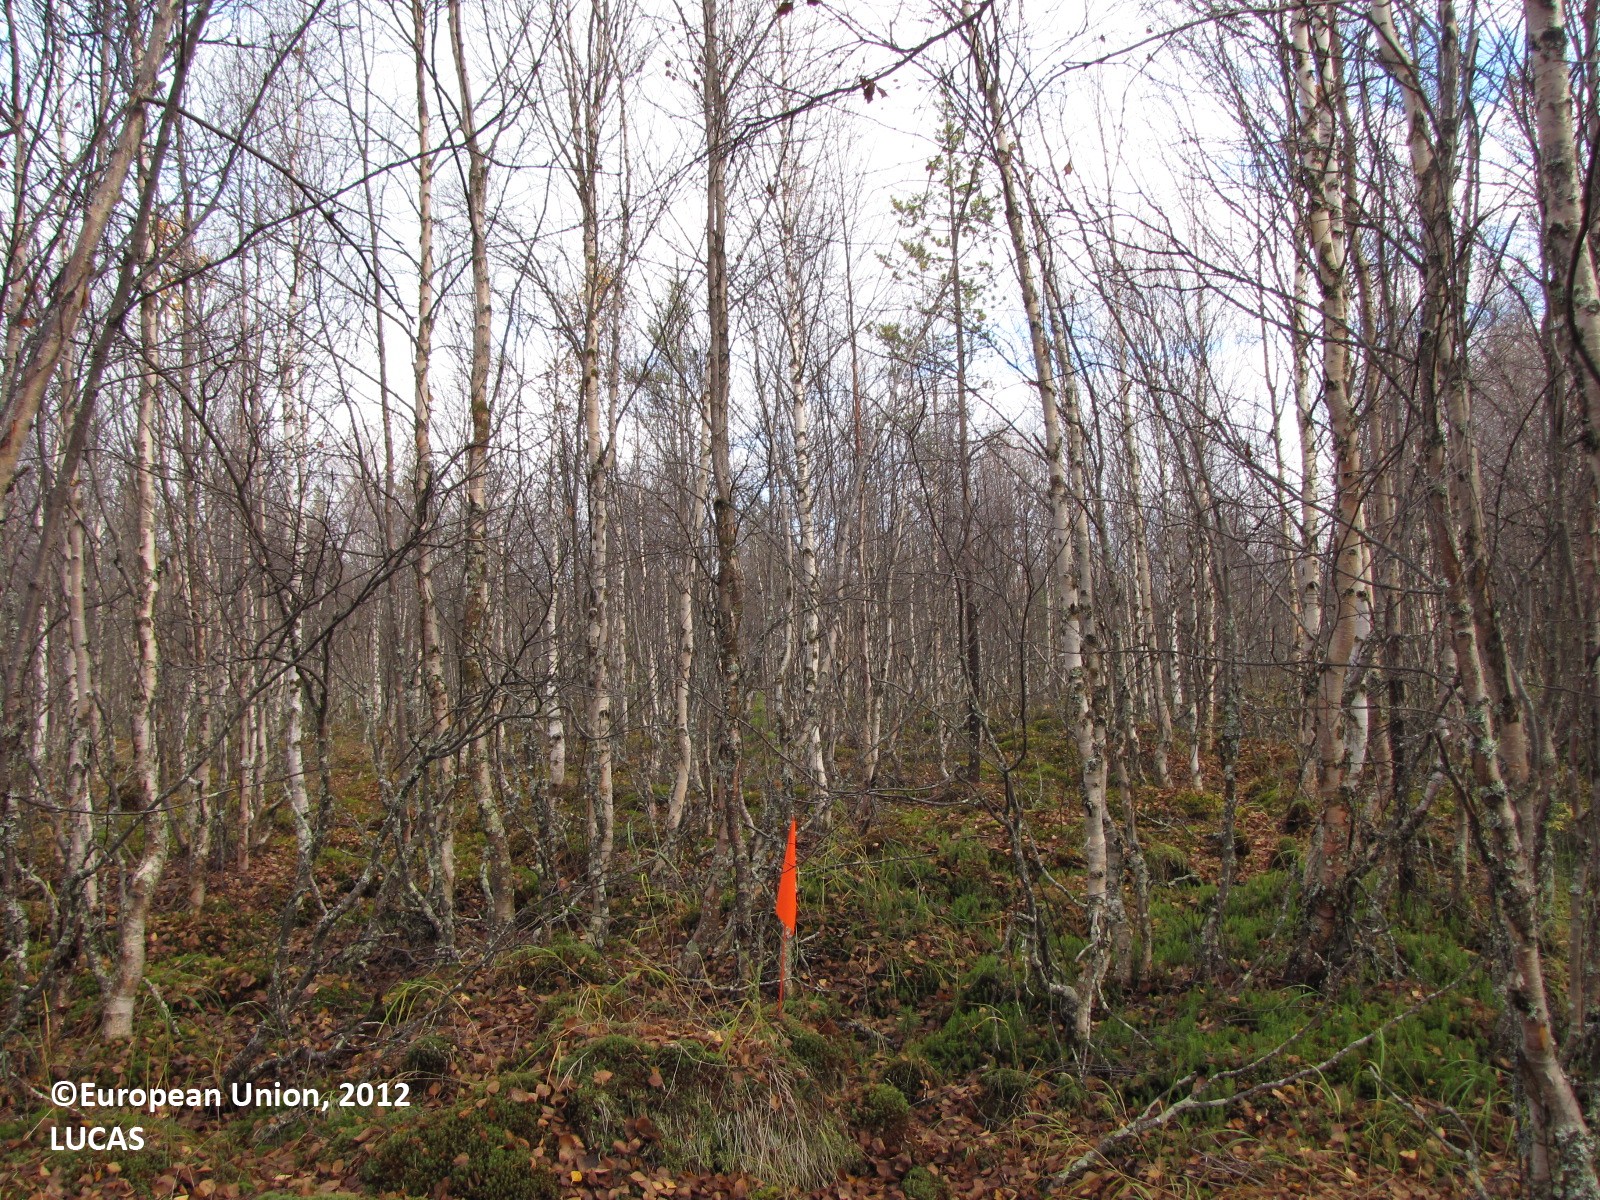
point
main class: Woodland
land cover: Broadleaved woodland
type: boreal forest
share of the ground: > 75 %
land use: Forestry
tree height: > 5 m
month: September
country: FI
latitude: 67.4781
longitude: 25.1319
